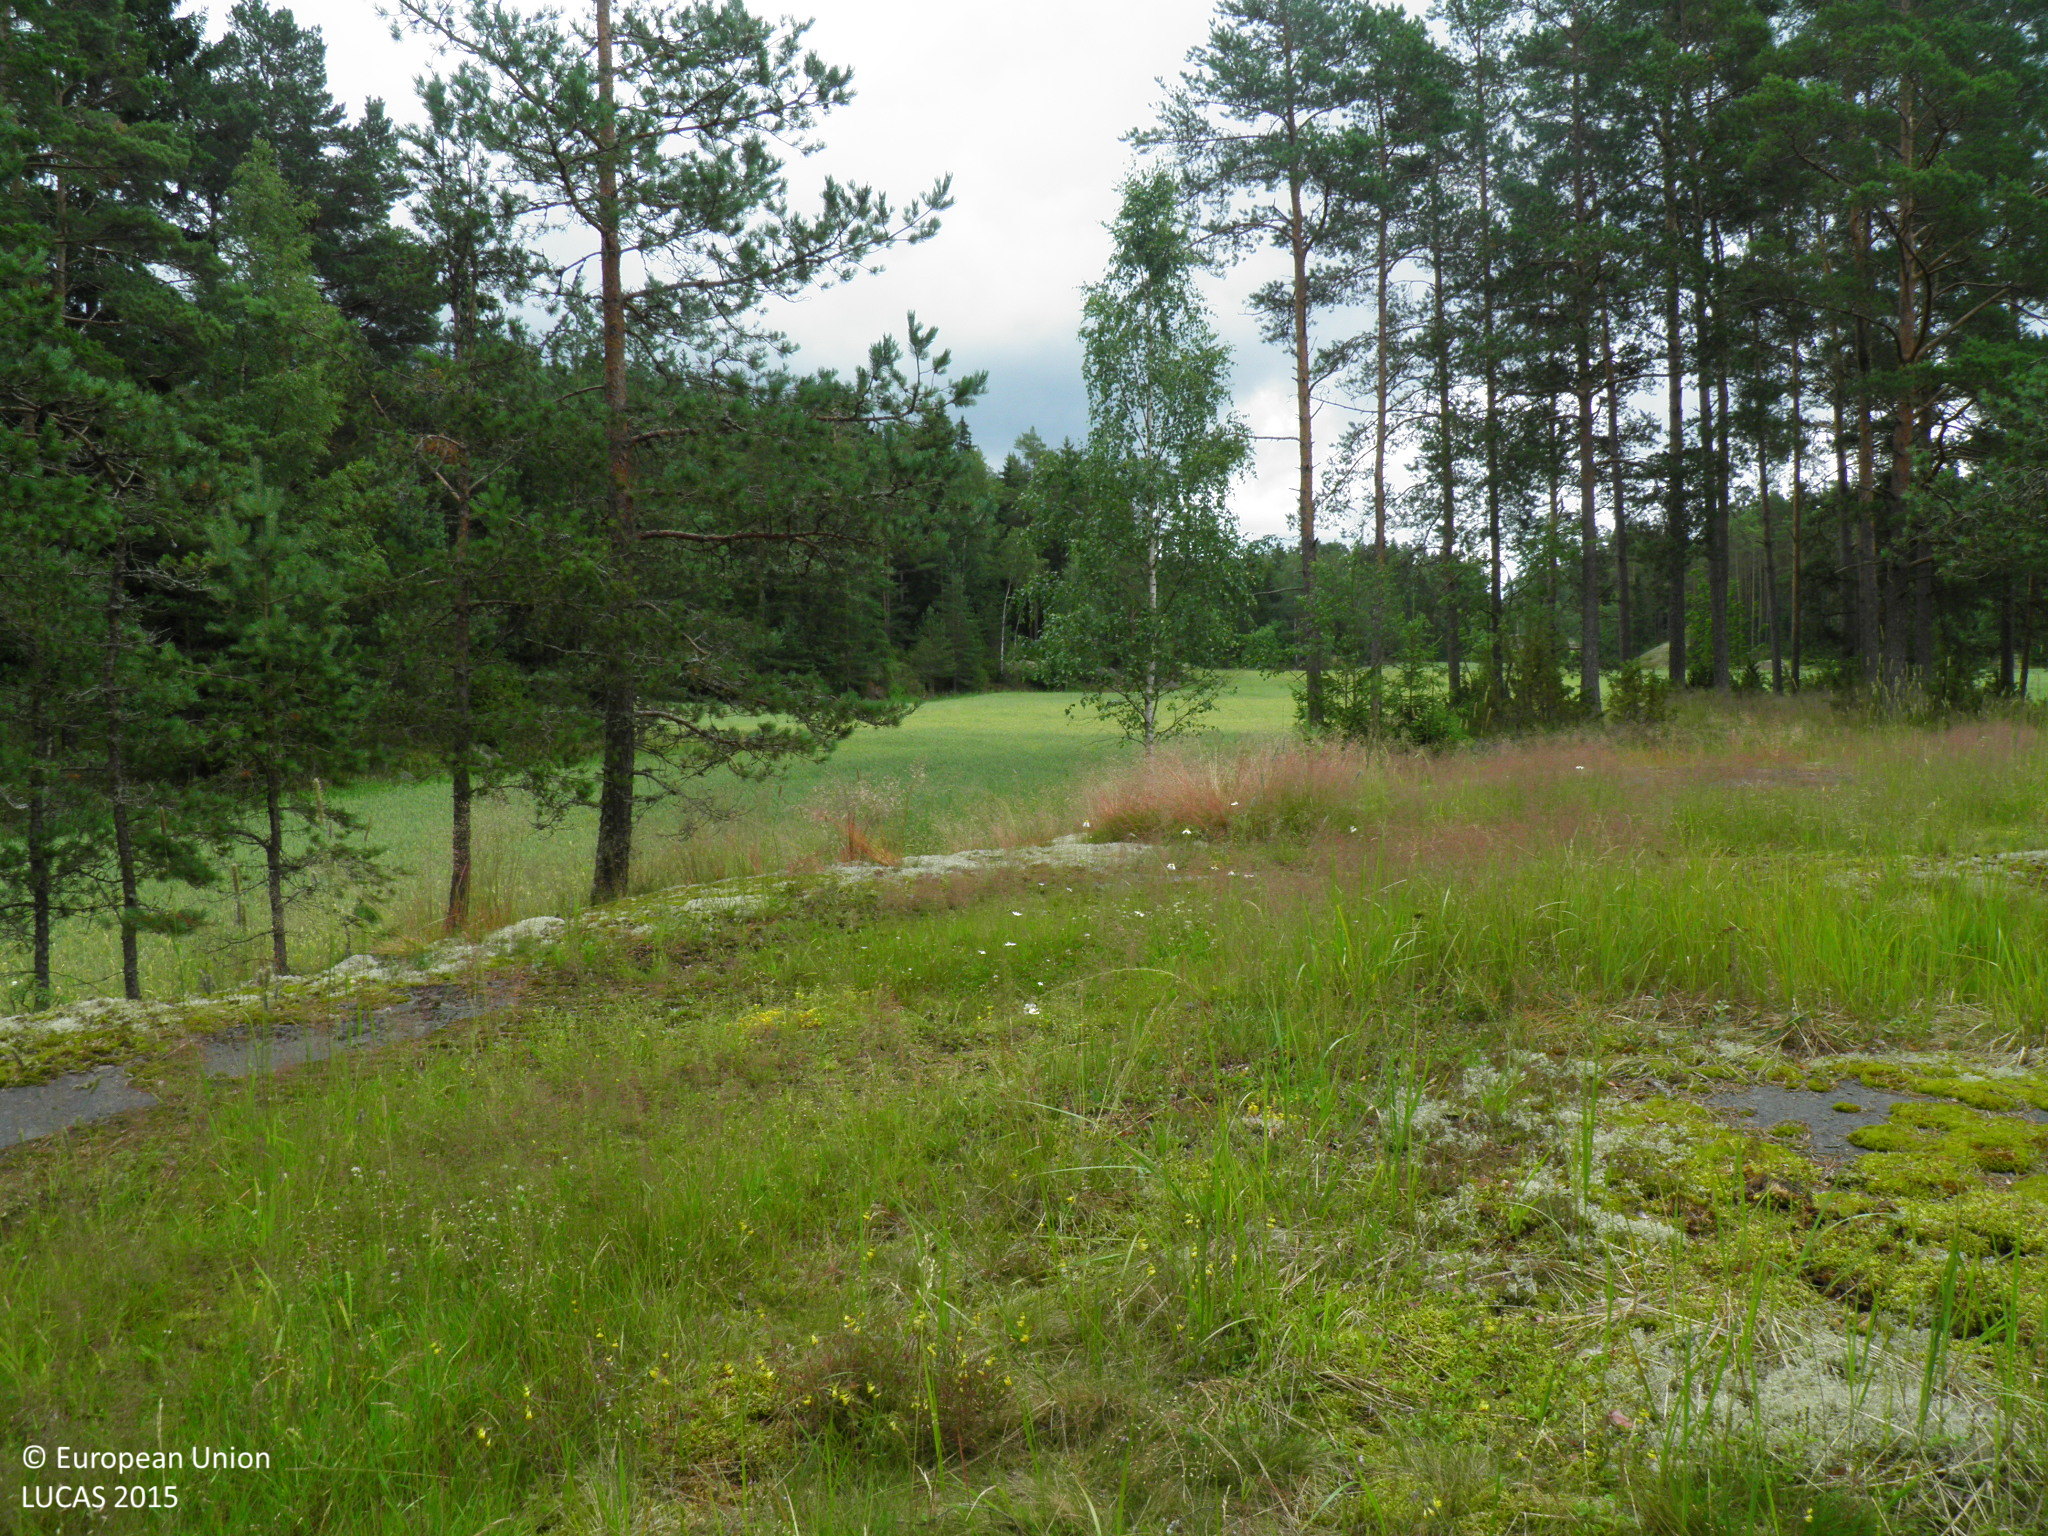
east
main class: Woodland
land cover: Pine dominated coniferous woodland
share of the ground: 10 - 25 %
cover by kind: herbaceous plants 30 %, lichens and mosses 30 %, coniferous forest trees 20 %, shrubs 10 %, consolidated bare surface 10 %
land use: Semi-natural and natural areas not in use
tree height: > 5 m
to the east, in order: Pine dominated coniferous woodland; Ditches and canals; Grass margins; Common wheat; Grass margins; Ditches and canals; Grass margins; Common wheat; Grass margins; Ditches and canals; Pine dominated coniferous woodland; Spruce dominated coniferous woodland; Ditches and canals; Grass margins; Barley
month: July
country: FI
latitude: 60.6572
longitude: 21.7117
